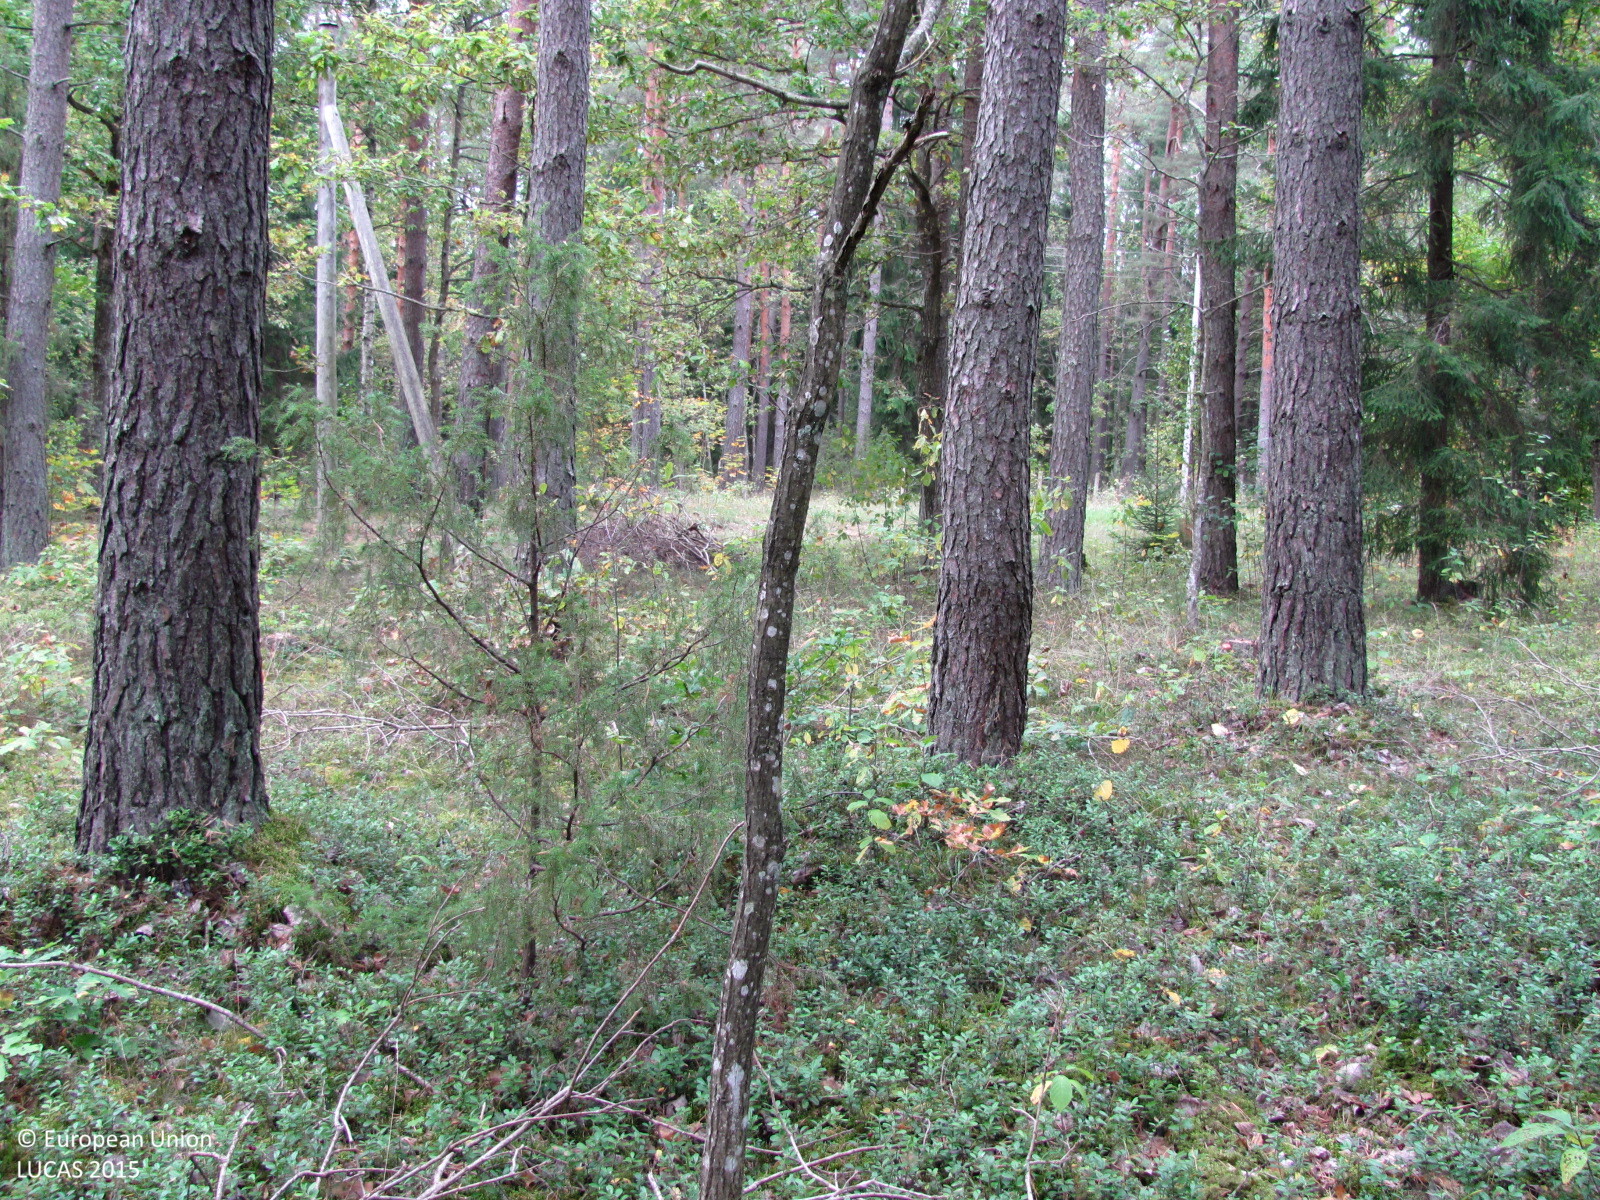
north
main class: Woodland
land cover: Other mixed woodland
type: hemiboreal forest and nemoral coniferous forest and mixed broadleaved-coniferous forest
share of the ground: > 75 %
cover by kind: broadleaved forest trees 55 %, coniferous forest trees 25 %, herbaceous plants 10 %, lichens and mosses 10 %
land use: Forestry
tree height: > 5 m
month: September
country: LV
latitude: 57.1110
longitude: 24.5419
